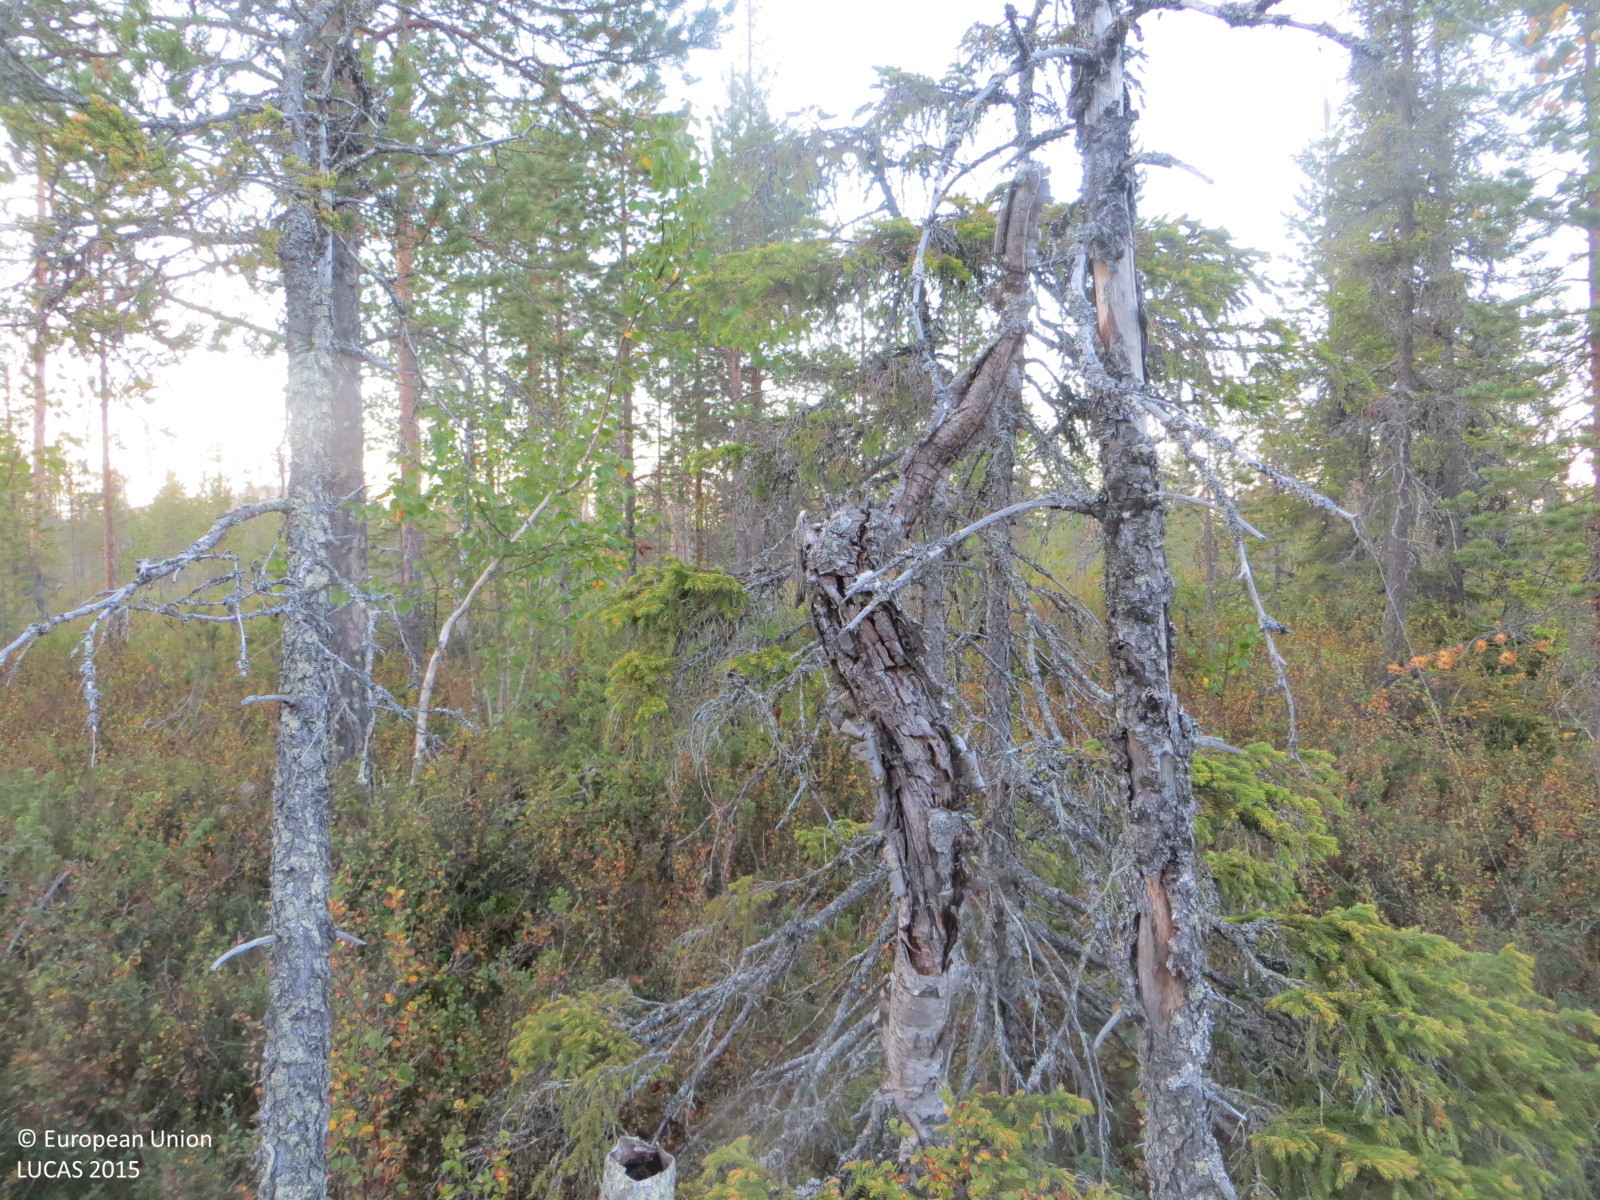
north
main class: Woodland
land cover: Pine dominated mixed woodland
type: mire and swamp forests
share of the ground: 50 - 75 %
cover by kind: shrubs 50 %, coniferous forest trees 30 %, broadleaved forest trees 20 %
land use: Forestry
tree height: > 5 m
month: August
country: FI
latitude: 67.7420
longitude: 24.8667
